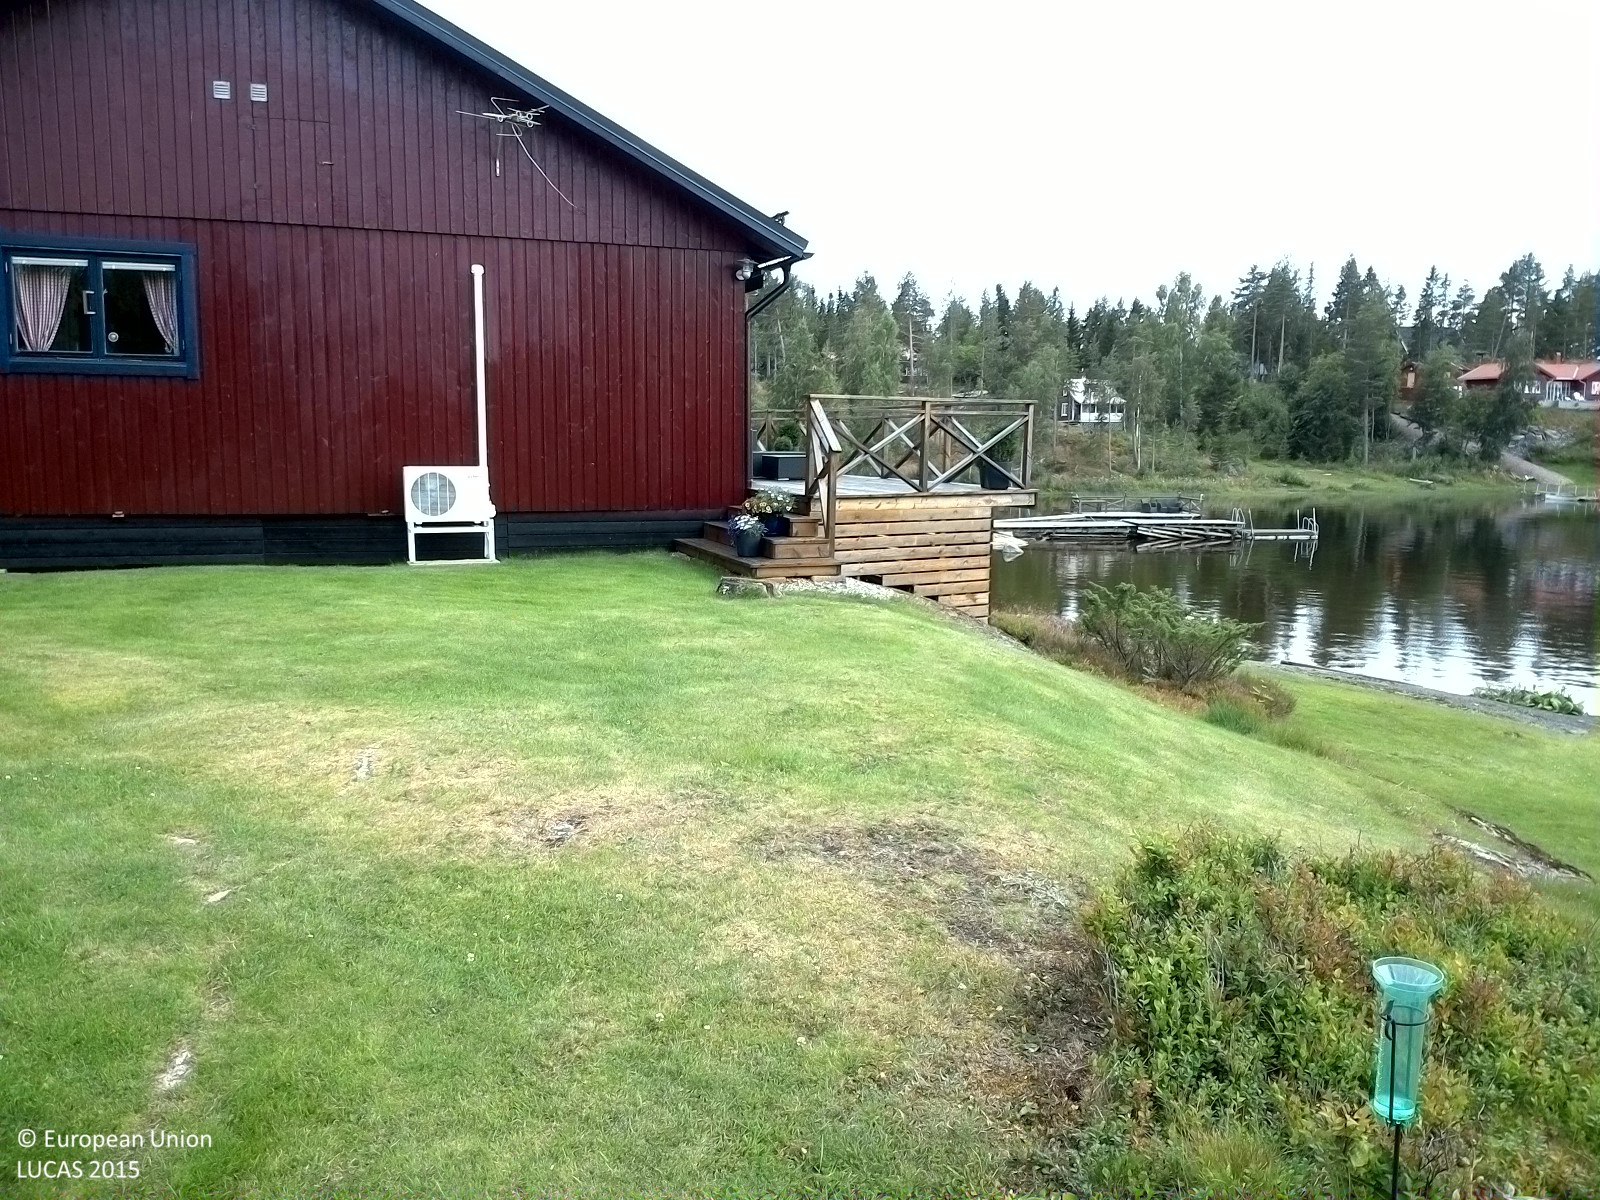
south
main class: Grassland
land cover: Grassland without tree/shrub cover
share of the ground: > 75 %
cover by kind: herbaceous plants 100 %
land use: Residential
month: August
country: SE
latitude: 62.2815
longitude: 17.4781
